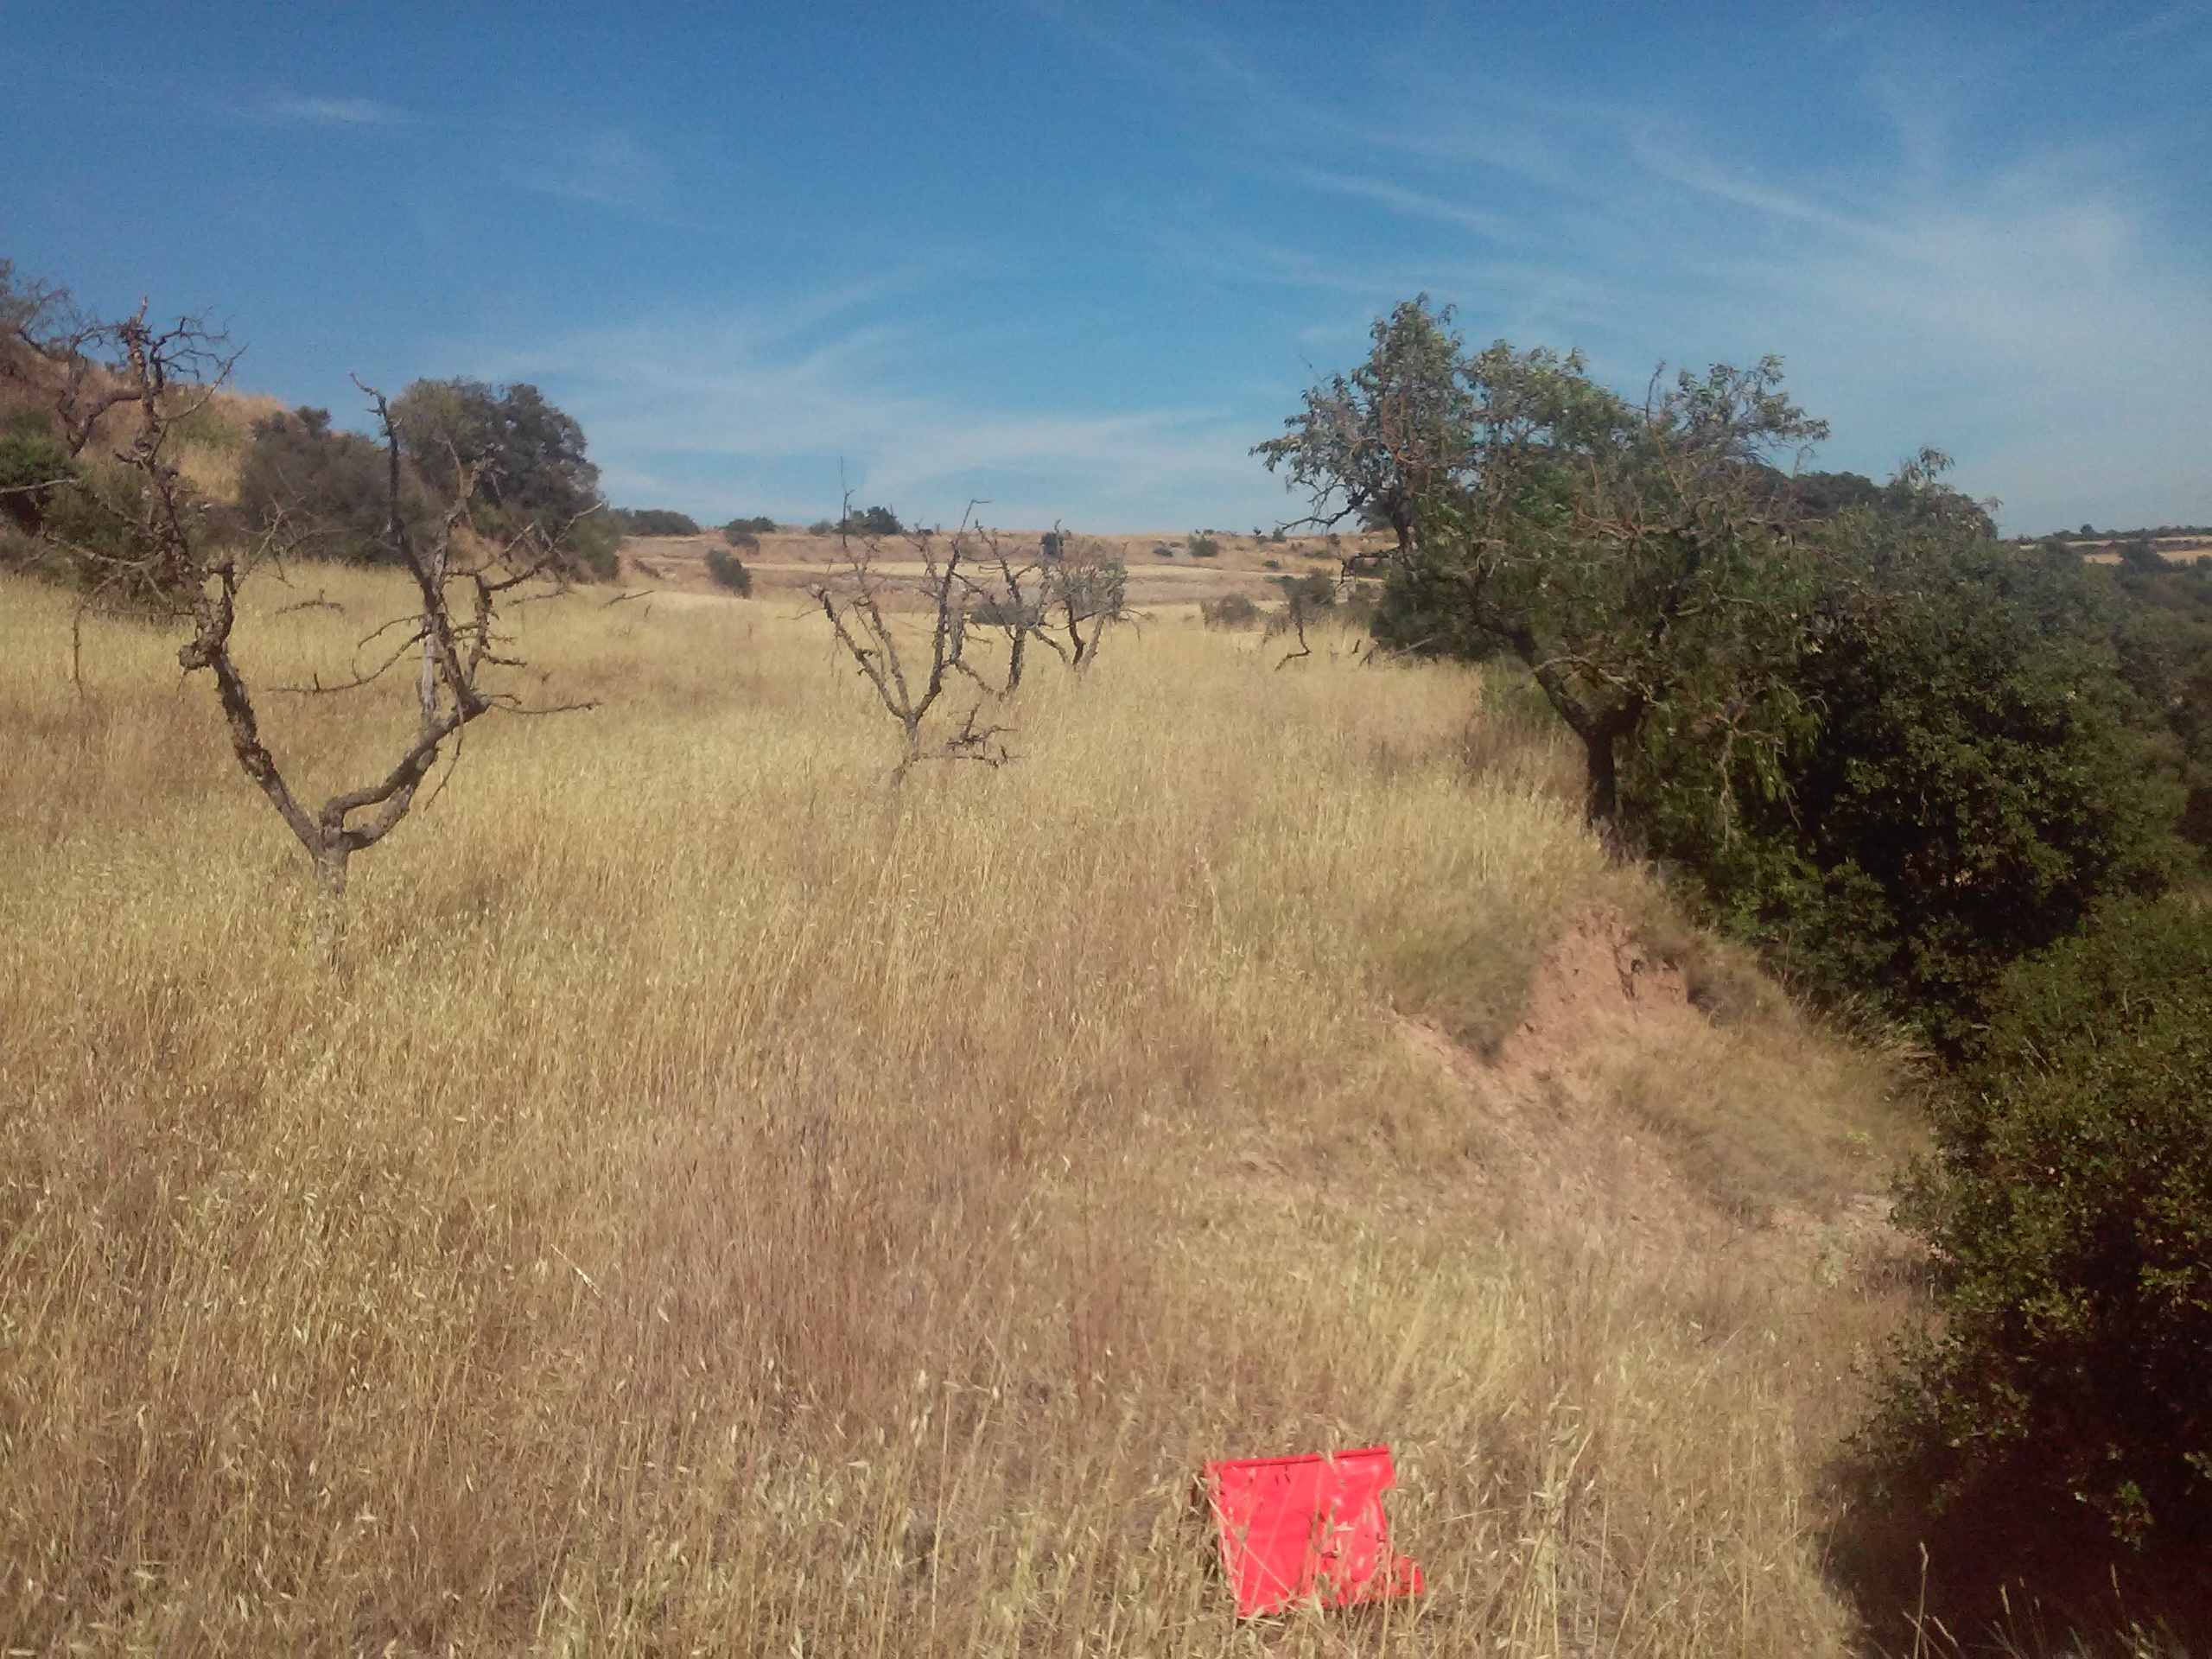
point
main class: Grassland
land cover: Grassland without tree/shrub cover
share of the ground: > 75 %
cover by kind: herbaceous plants 90 %, shrubs 5 %, consolidated bare surface 5 %
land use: Abandoned areas
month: July
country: ES
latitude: 41.5442
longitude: 1.2036
